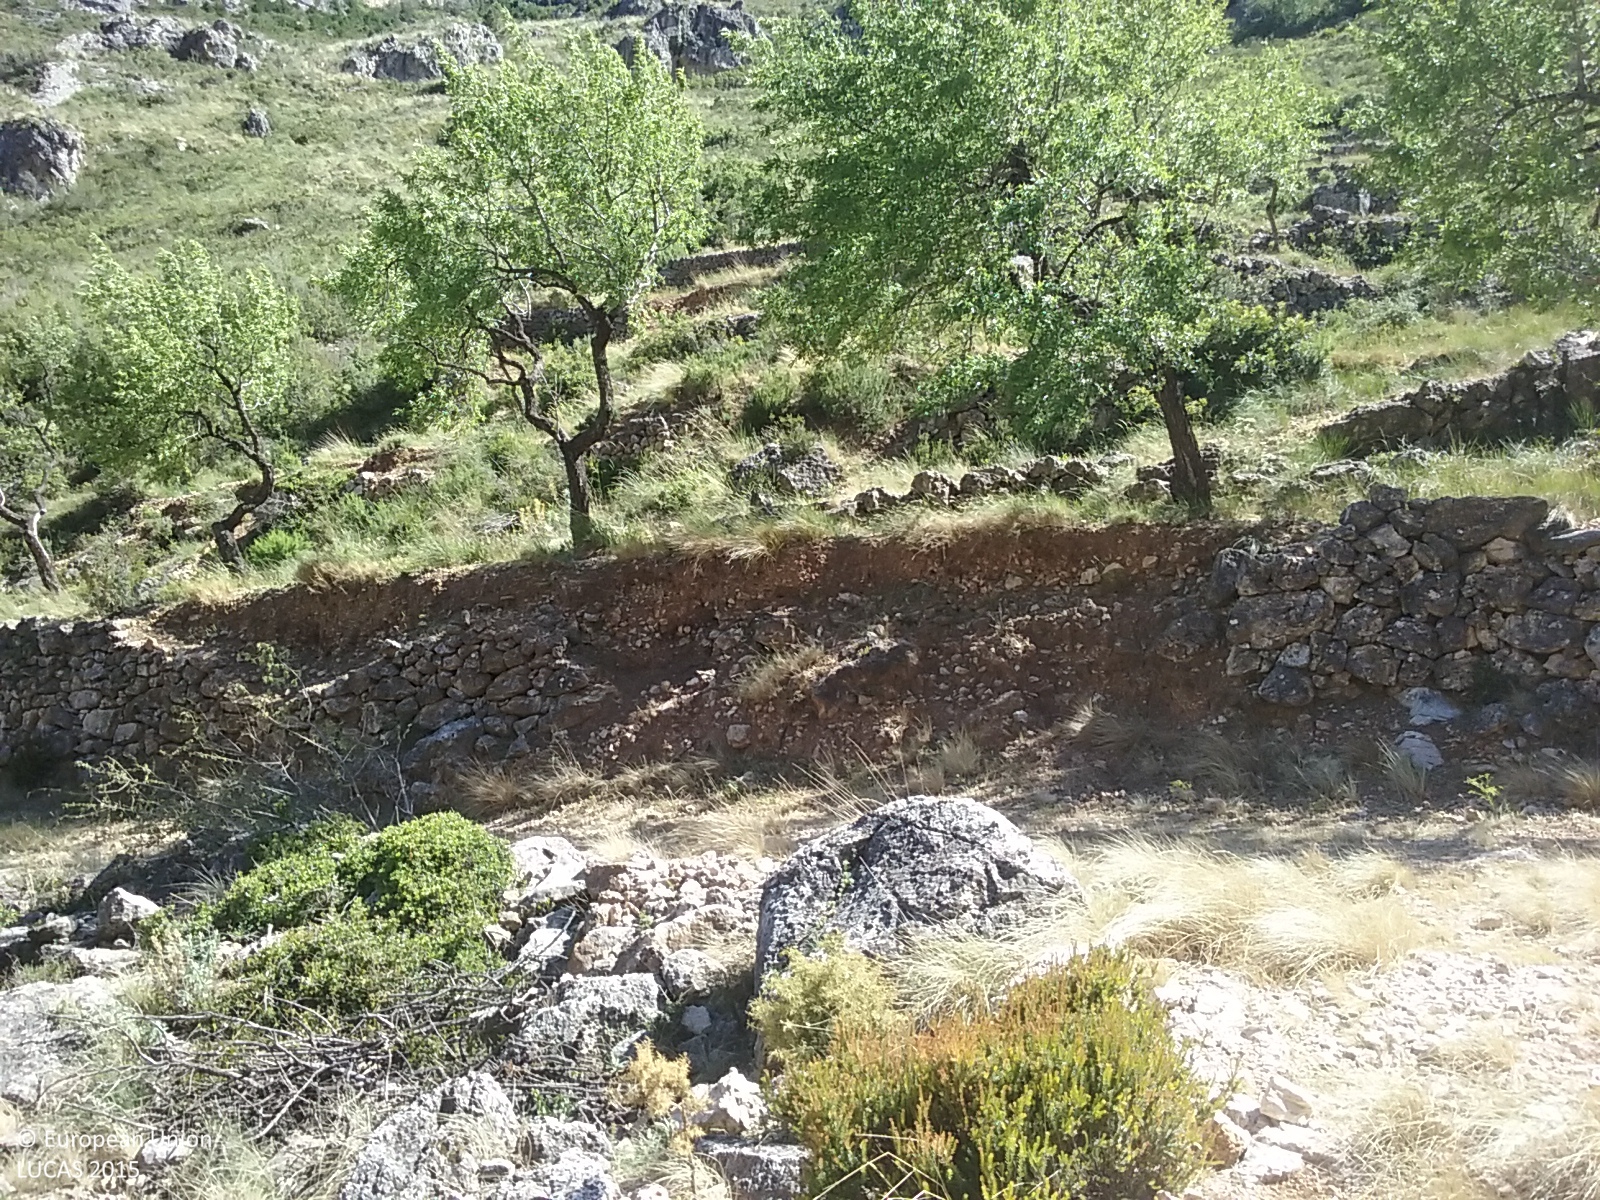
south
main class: Cropland
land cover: Olive groves
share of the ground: 25 - 50 %
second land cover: Other bare soil
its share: > 75 %
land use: Agriculture (excluding fallow land and kitchen gardens)
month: May
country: ES
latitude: 40.7770
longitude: 0.3843
